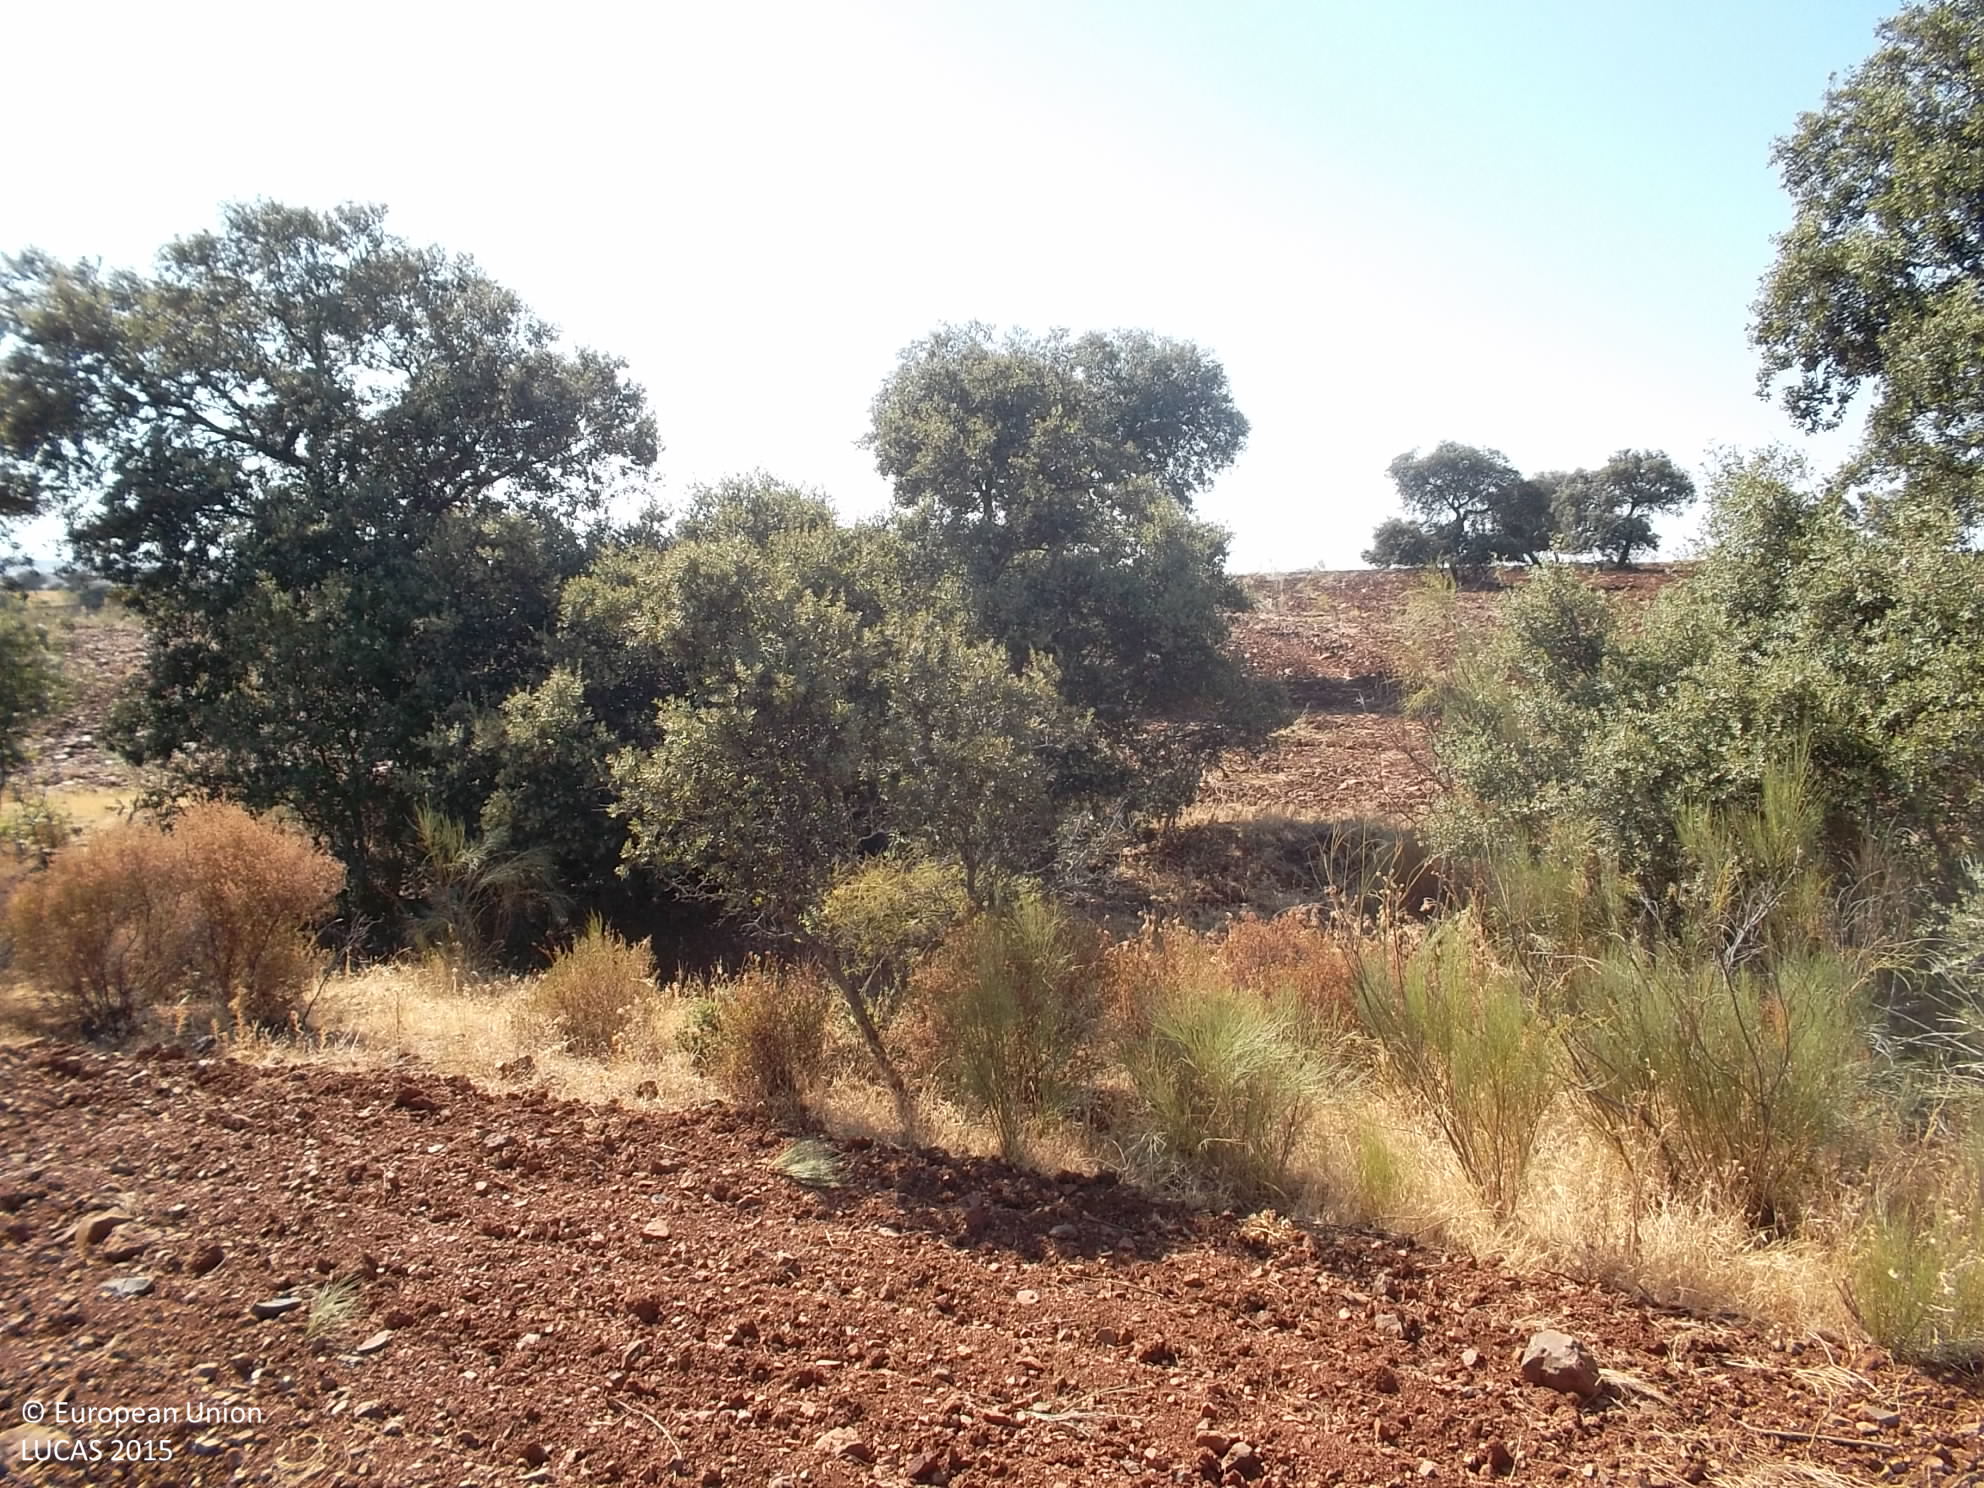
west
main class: Woodland
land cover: Broadleaved woodland
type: broadleaved evergreen forest
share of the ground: 10 - 25 %
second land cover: Spontaneously vegetated surfaces
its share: 10 - 25 %
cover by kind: unconsolidated bare surface 60 %, broadleaved forest trees 25 %, shrubs 15 %
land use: Agriculture (excluding fallow land and kitchen gardens)
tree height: > 5 m
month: July
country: ES
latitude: 38.5627
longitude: -5.7518
